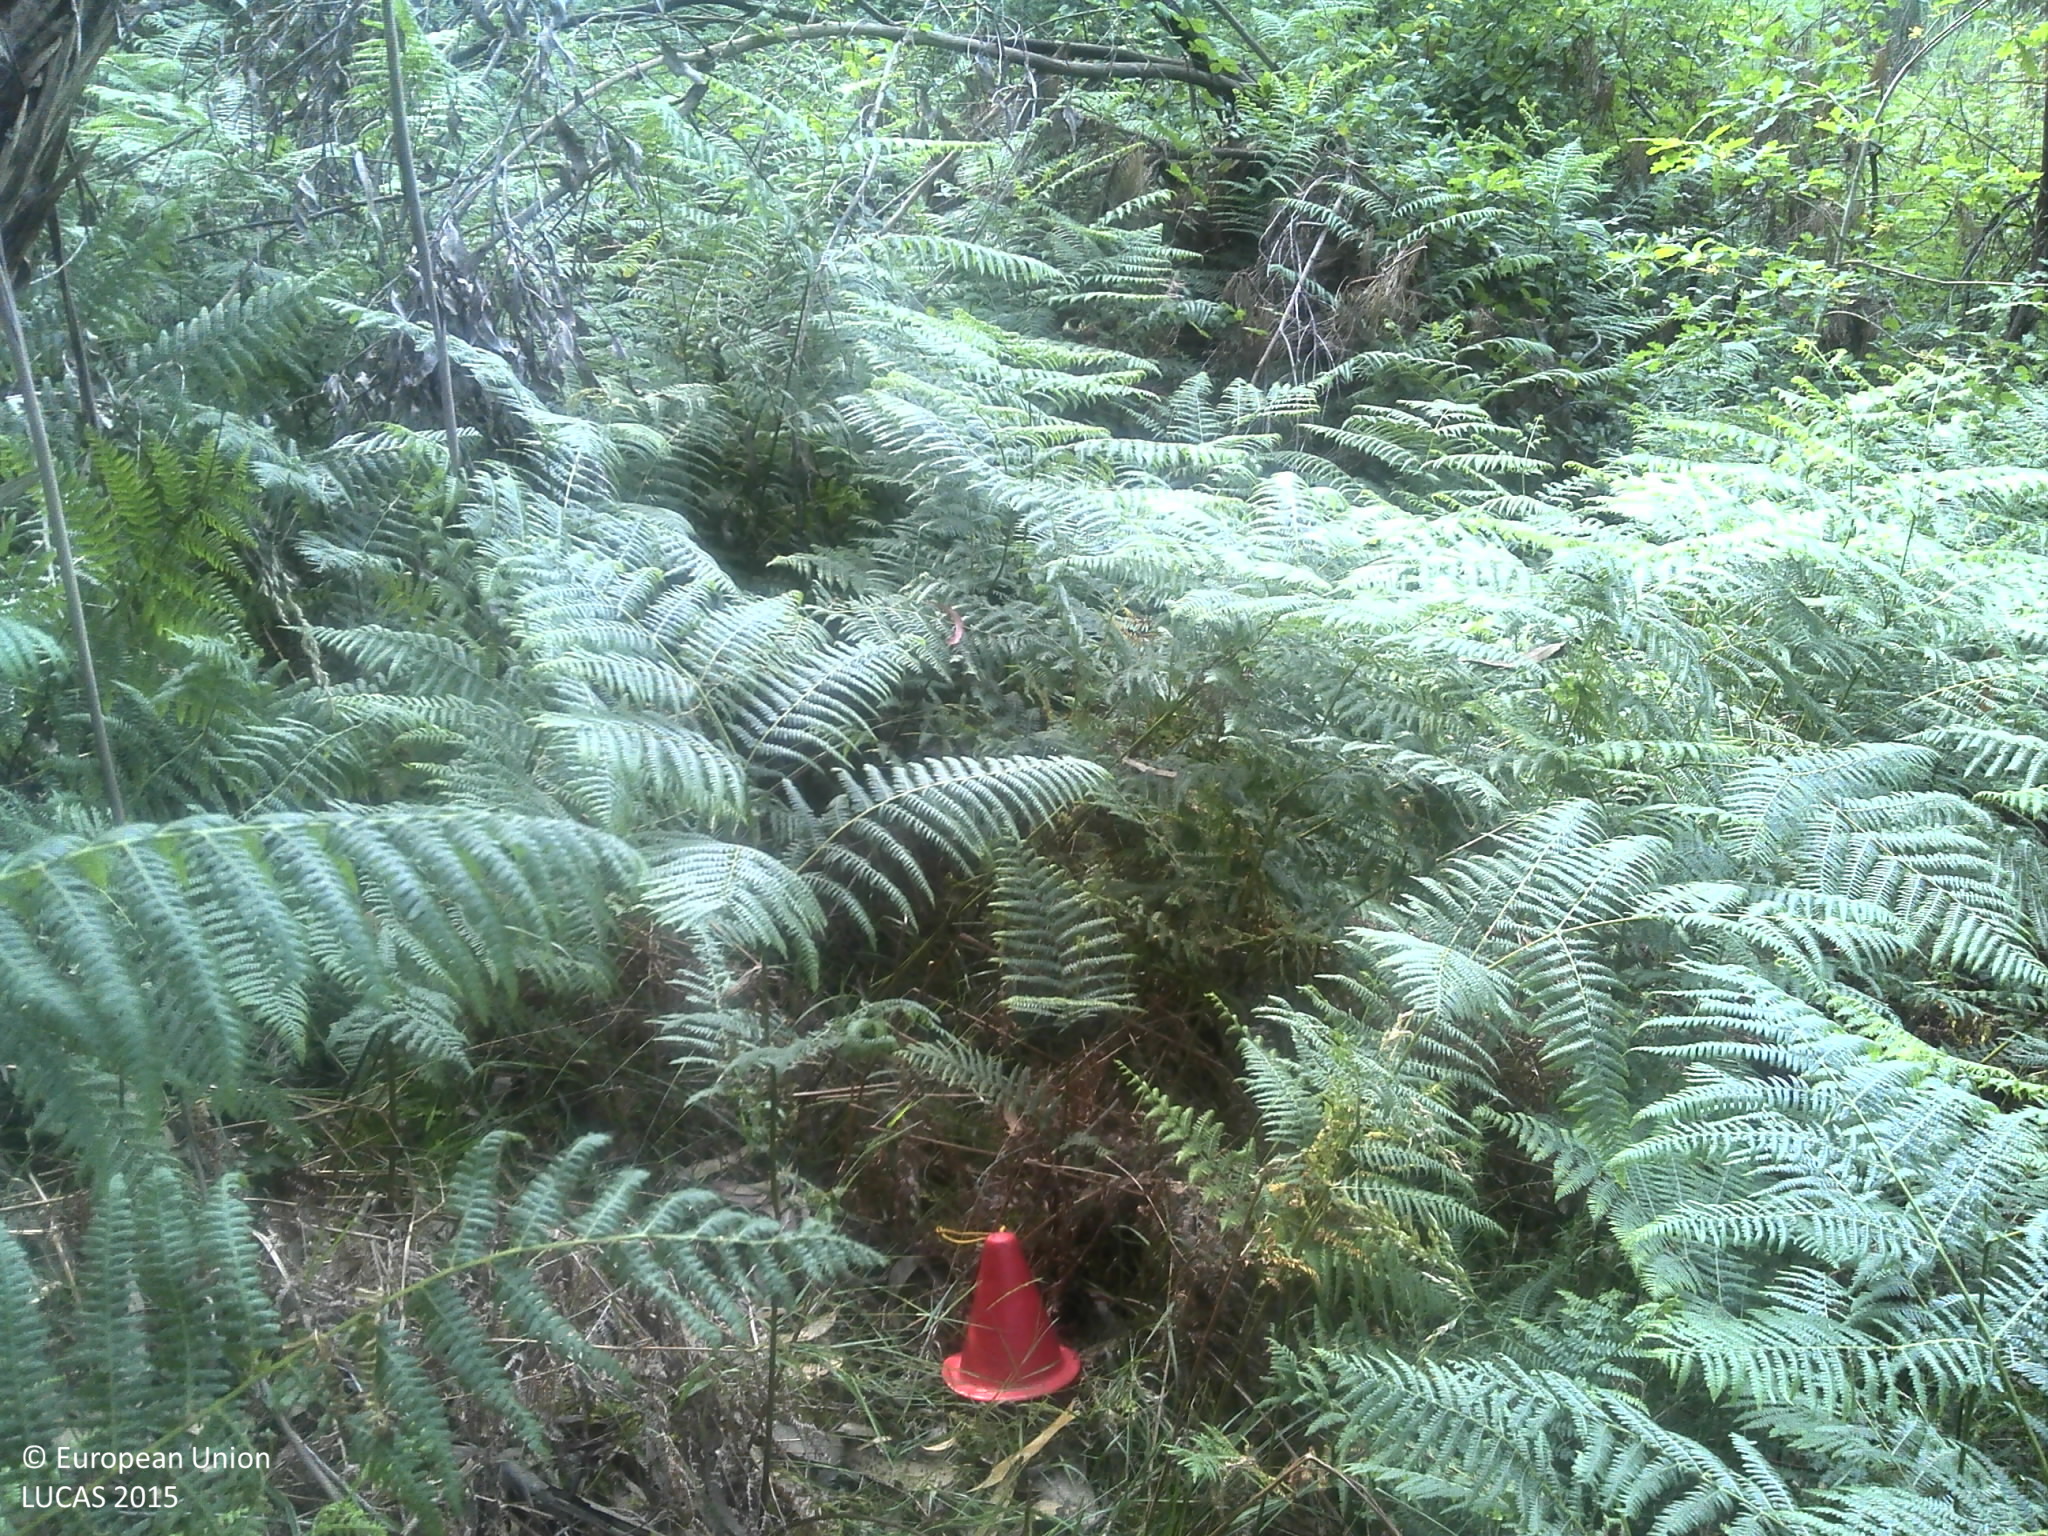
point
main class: Woodland
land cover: Broadleaved woodland
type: exotic forest
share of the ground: 50 - 75 %
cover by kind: broadleaved forest trees 70 %, shrubs 20 %, herbaceous plants 10 %
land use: Forestry
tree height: > 5 m
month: June
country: PT
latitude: 41.6629
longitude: -8.3480
